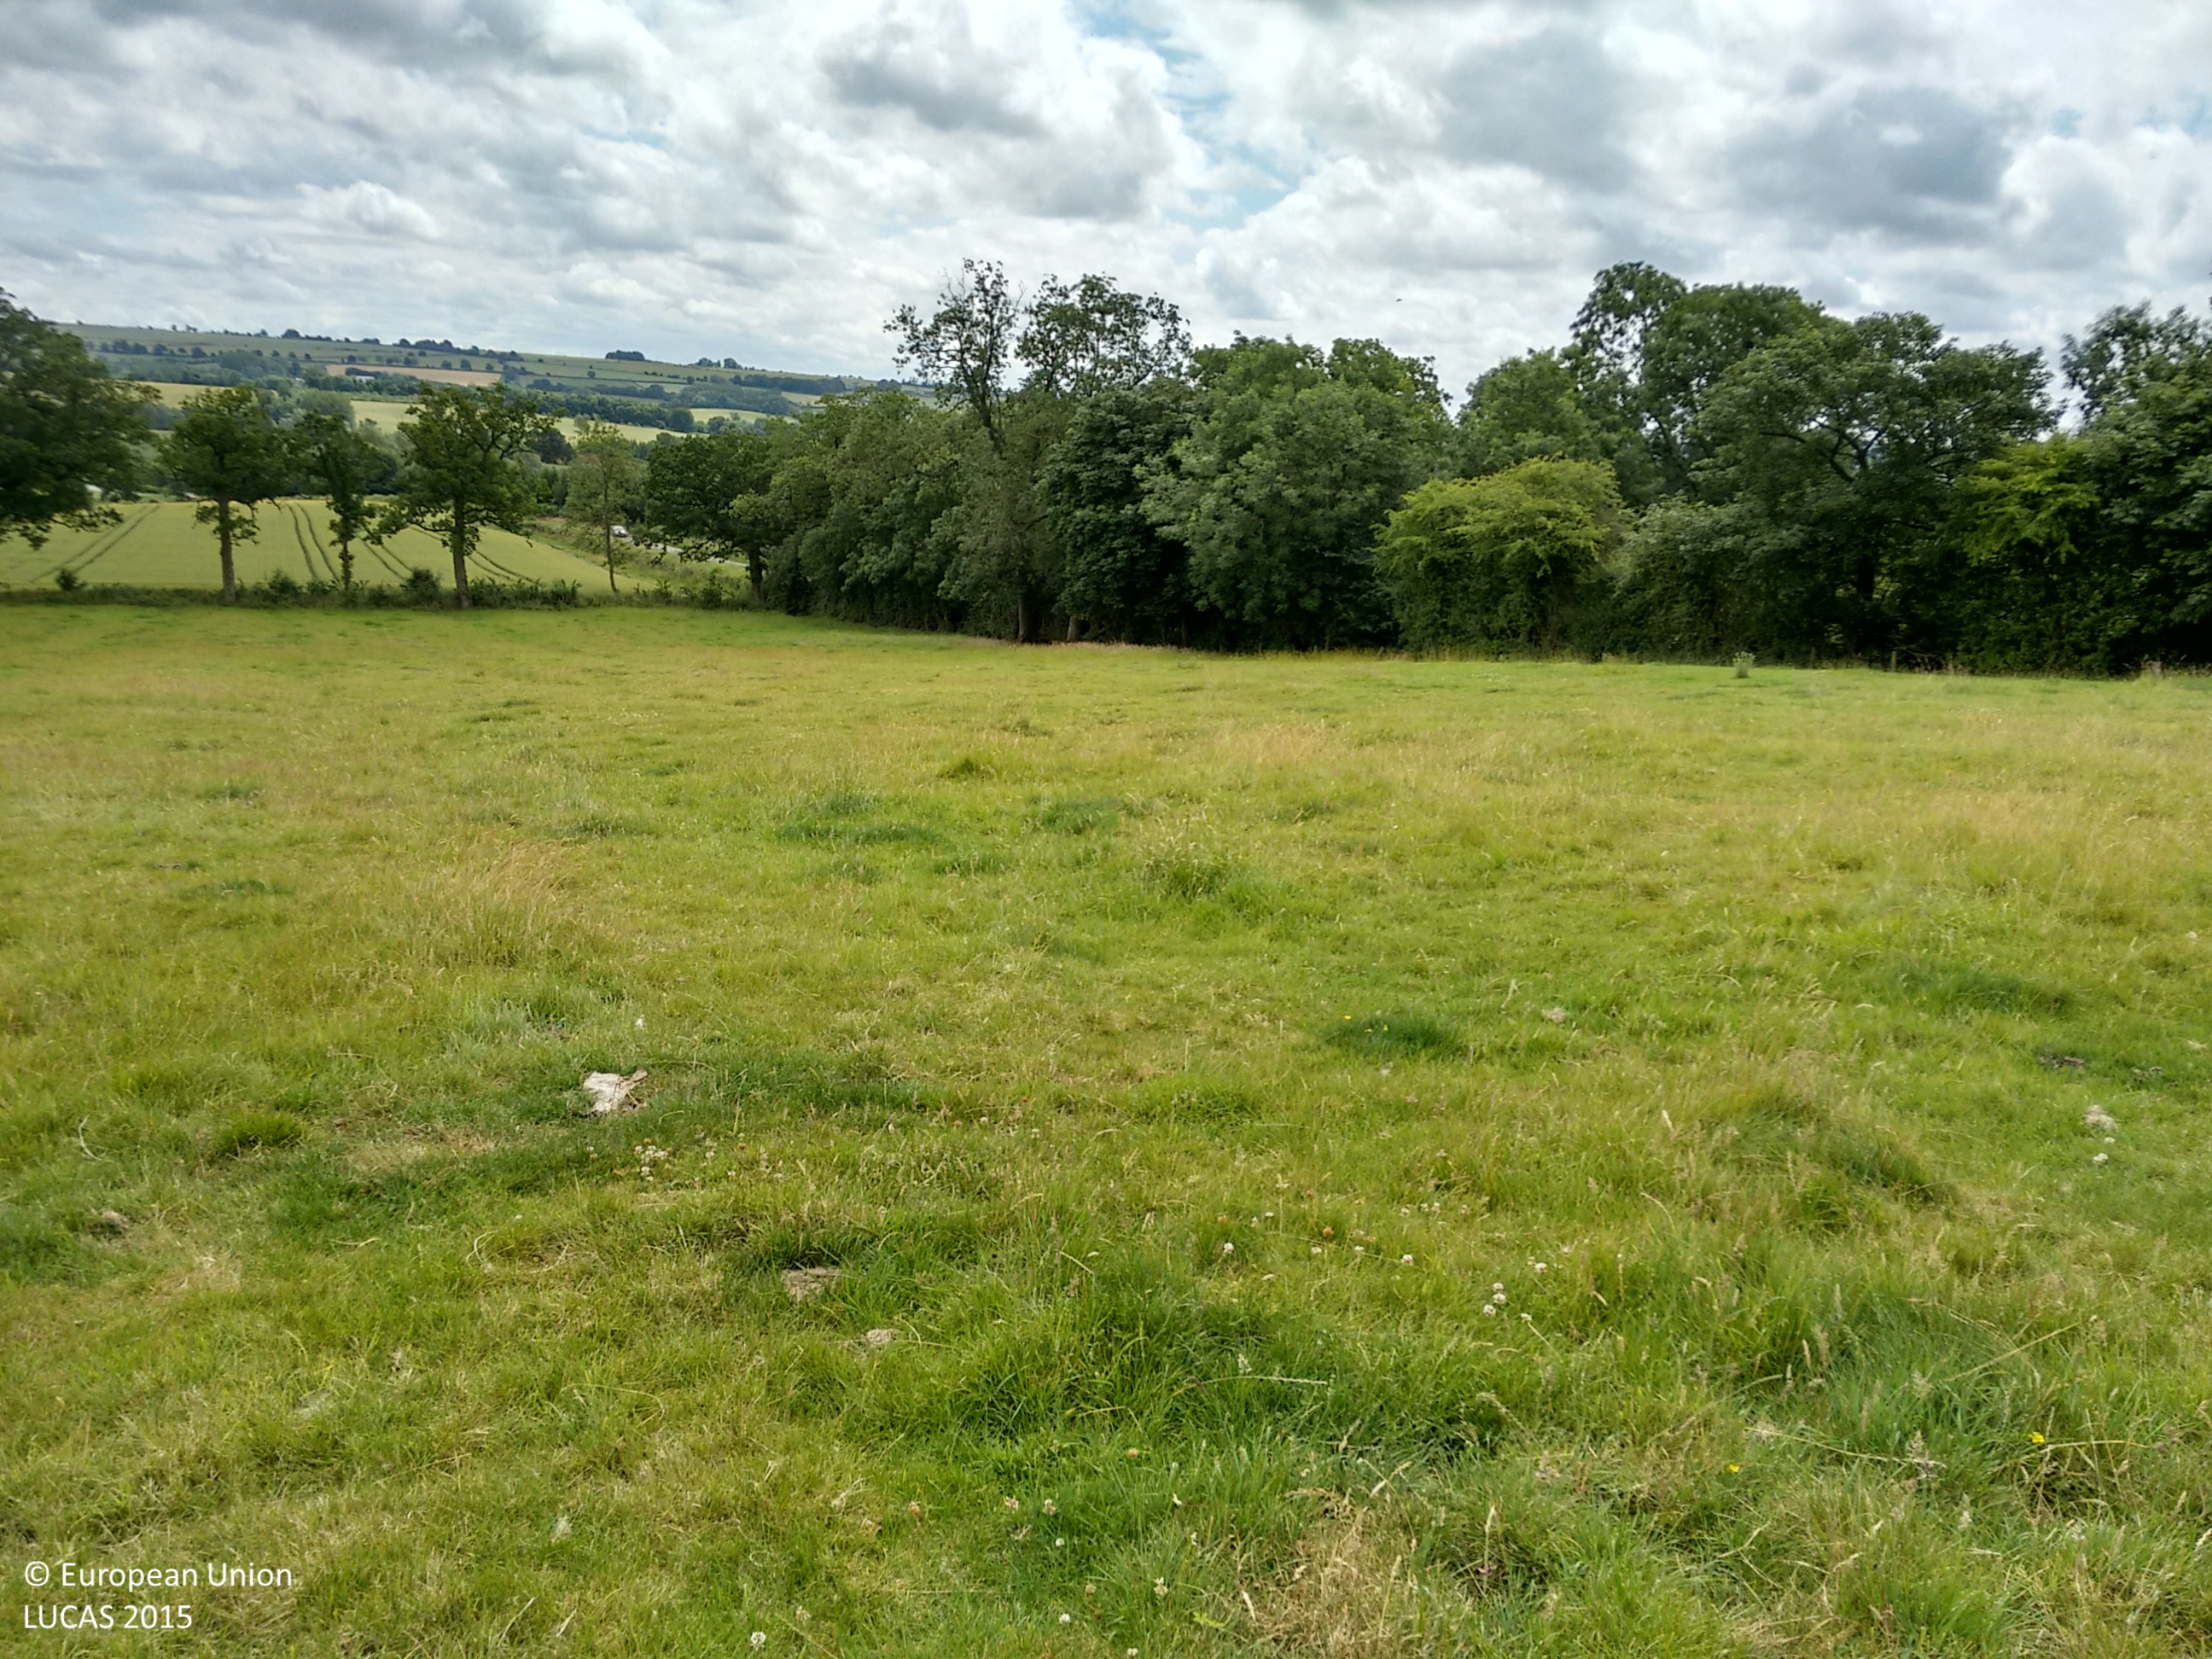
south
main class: Grassland
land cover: Grassland without tree/shrub cover
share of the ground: > 75 %
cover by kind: herbaceous plants 100 %
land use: Agriculture (excluding fallow land and kitchen gardens)
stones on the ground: < 10 %
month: July
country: GB
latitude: 51.9528
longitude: -1.5910
